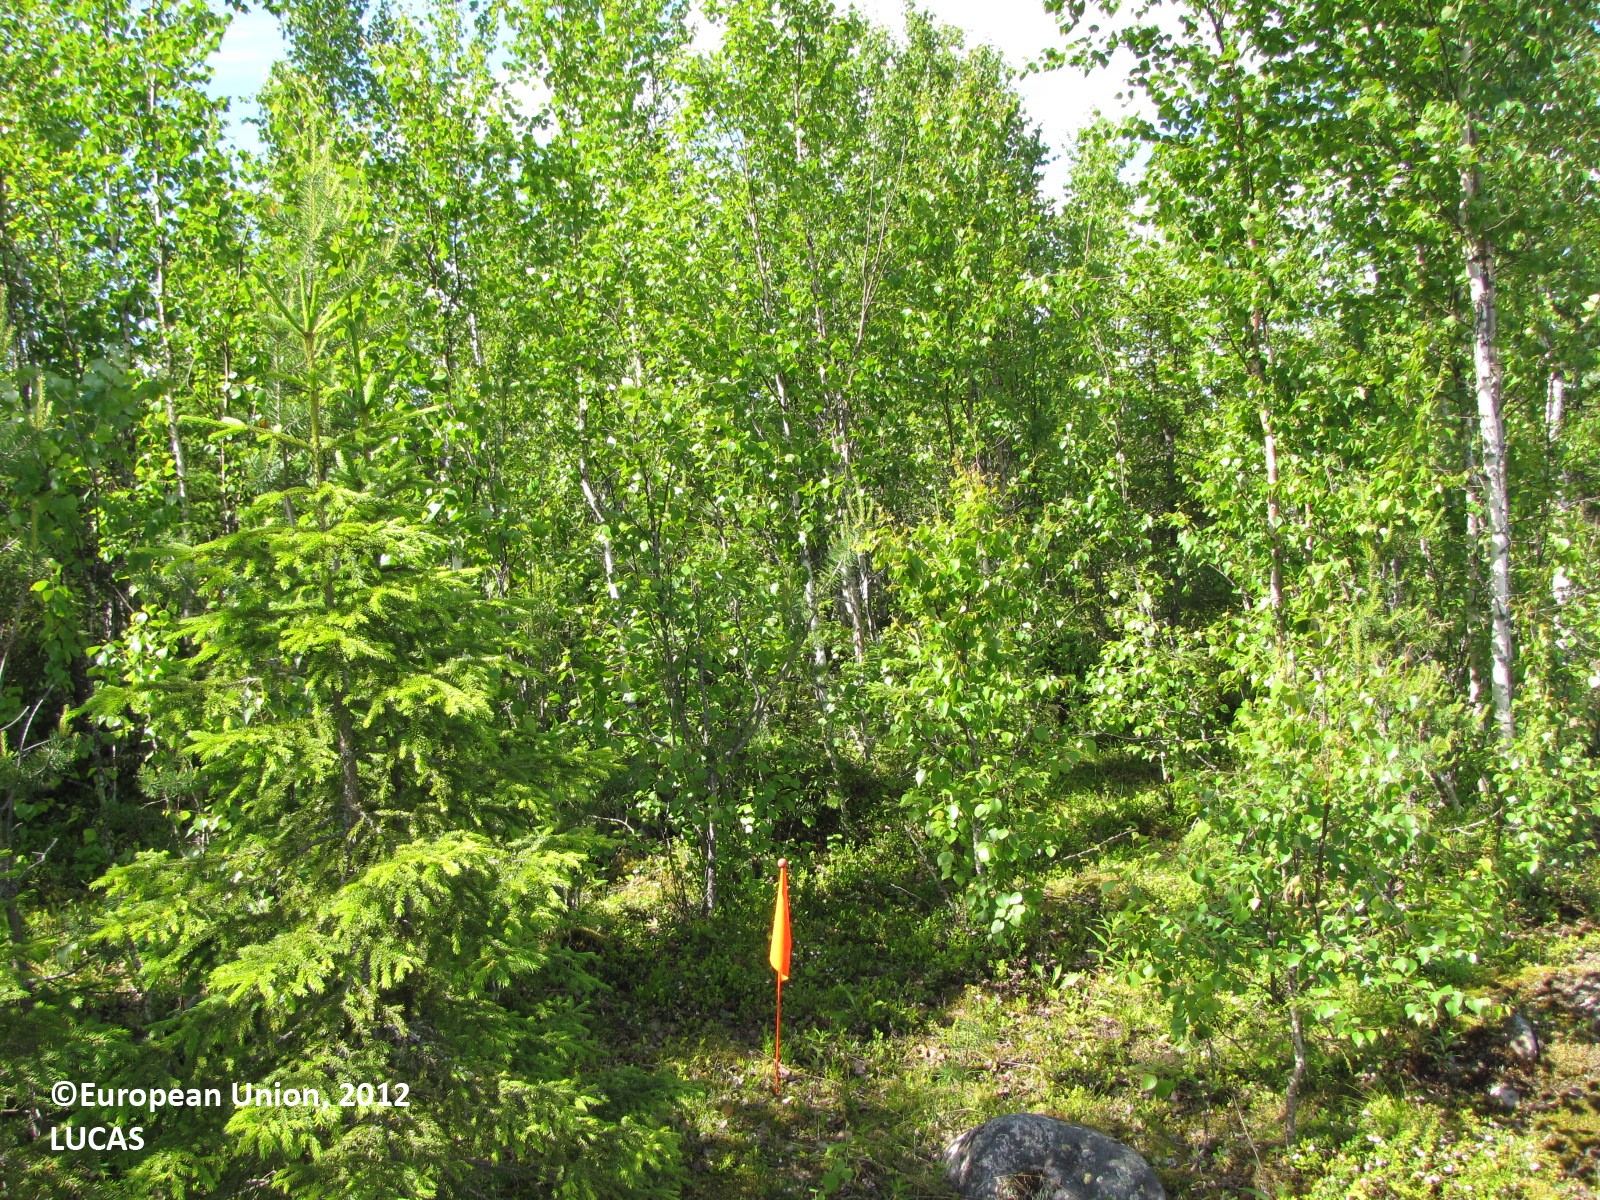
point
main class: Woodland
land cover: Broadleaved woodland
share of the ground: 50 - 75 %
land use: Forestry
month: July
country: FI
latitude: 66.1947
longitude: 25.1815
